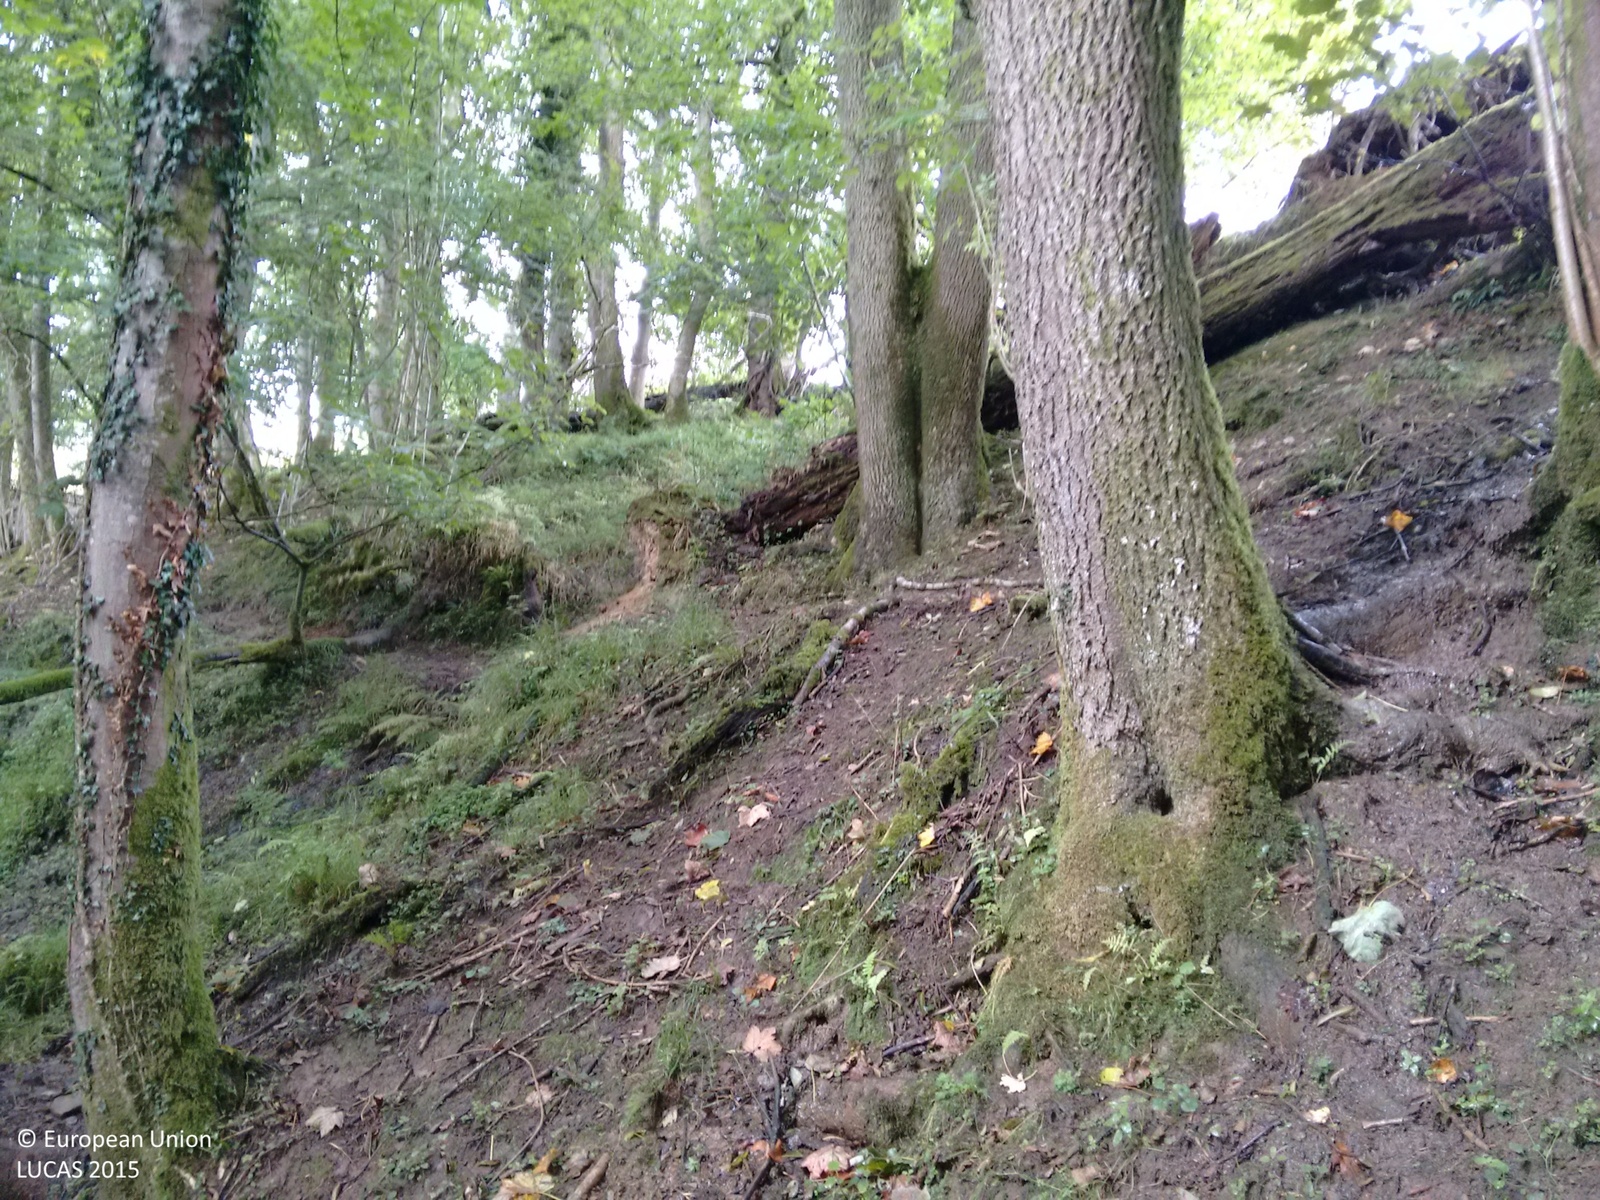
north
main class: Woodland
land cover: Broadleaved woodland
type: mesophytic deciduous forest
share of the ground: > 75 %
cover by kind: broadleaved forest trees 70 %, shrubs 20 %, consolidated bare surface 10 %
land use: Semi-natural and natural areas not in use
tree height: > 5 m
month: September
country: GB
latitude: 51.9978
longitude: -3.8556
